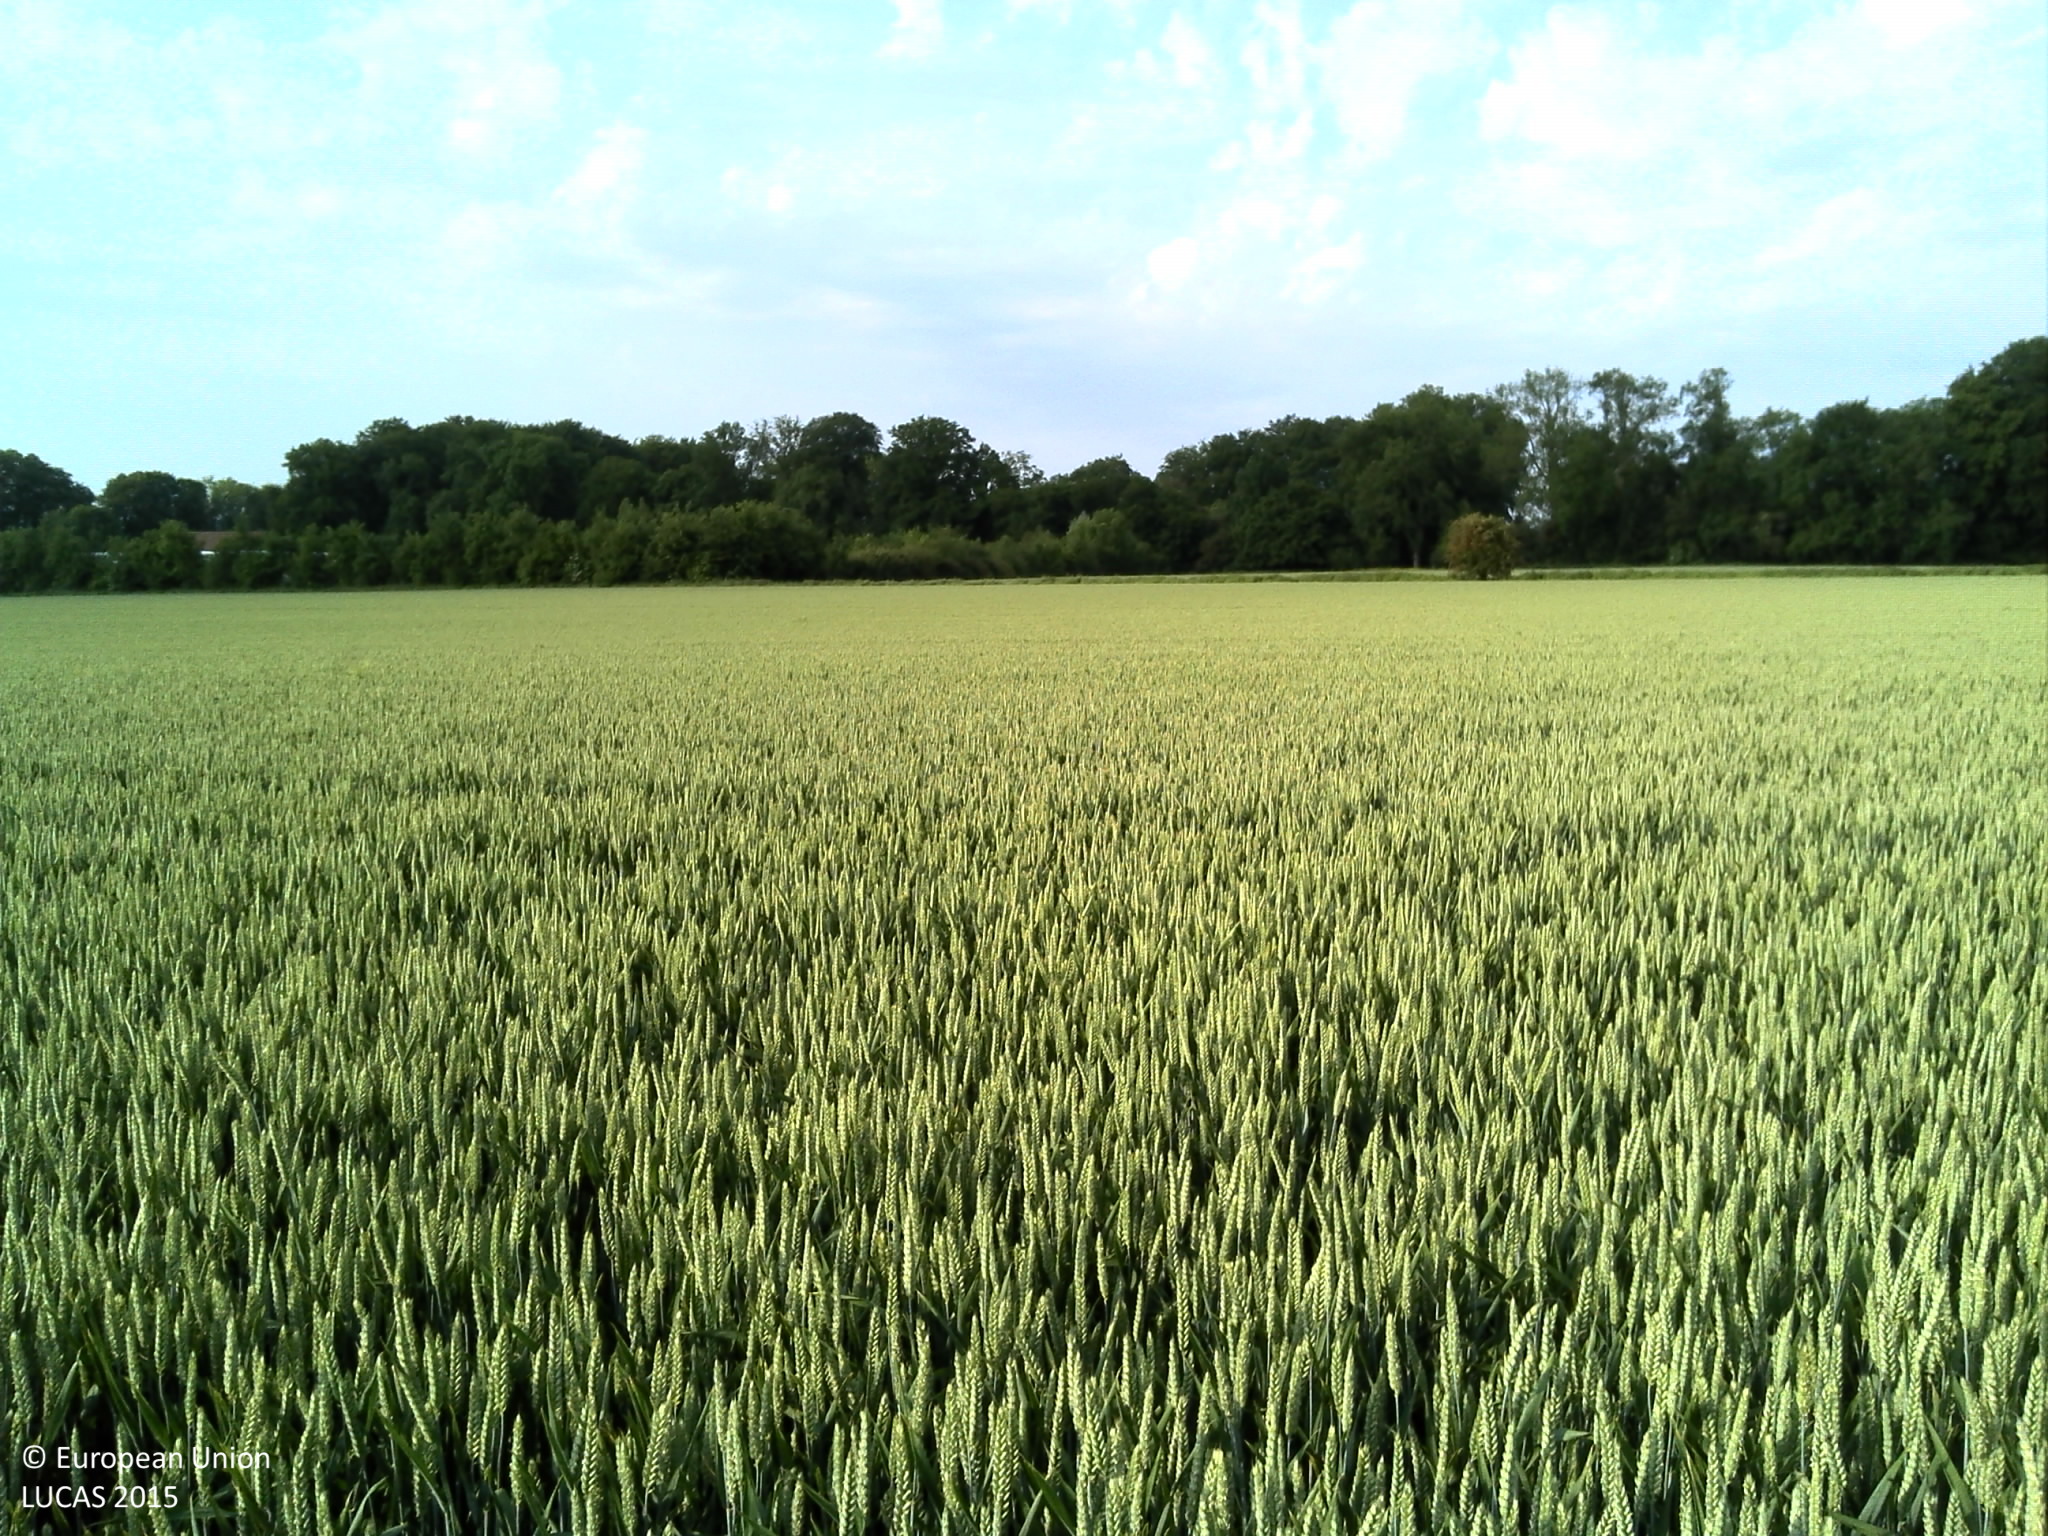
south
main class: Cropland
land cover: Common wheat
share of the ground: > 75 %
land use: Agriculture (excluding fallow land and kitchen gardens)
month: June
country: FR
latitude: 49.6790
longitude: 1.1786
